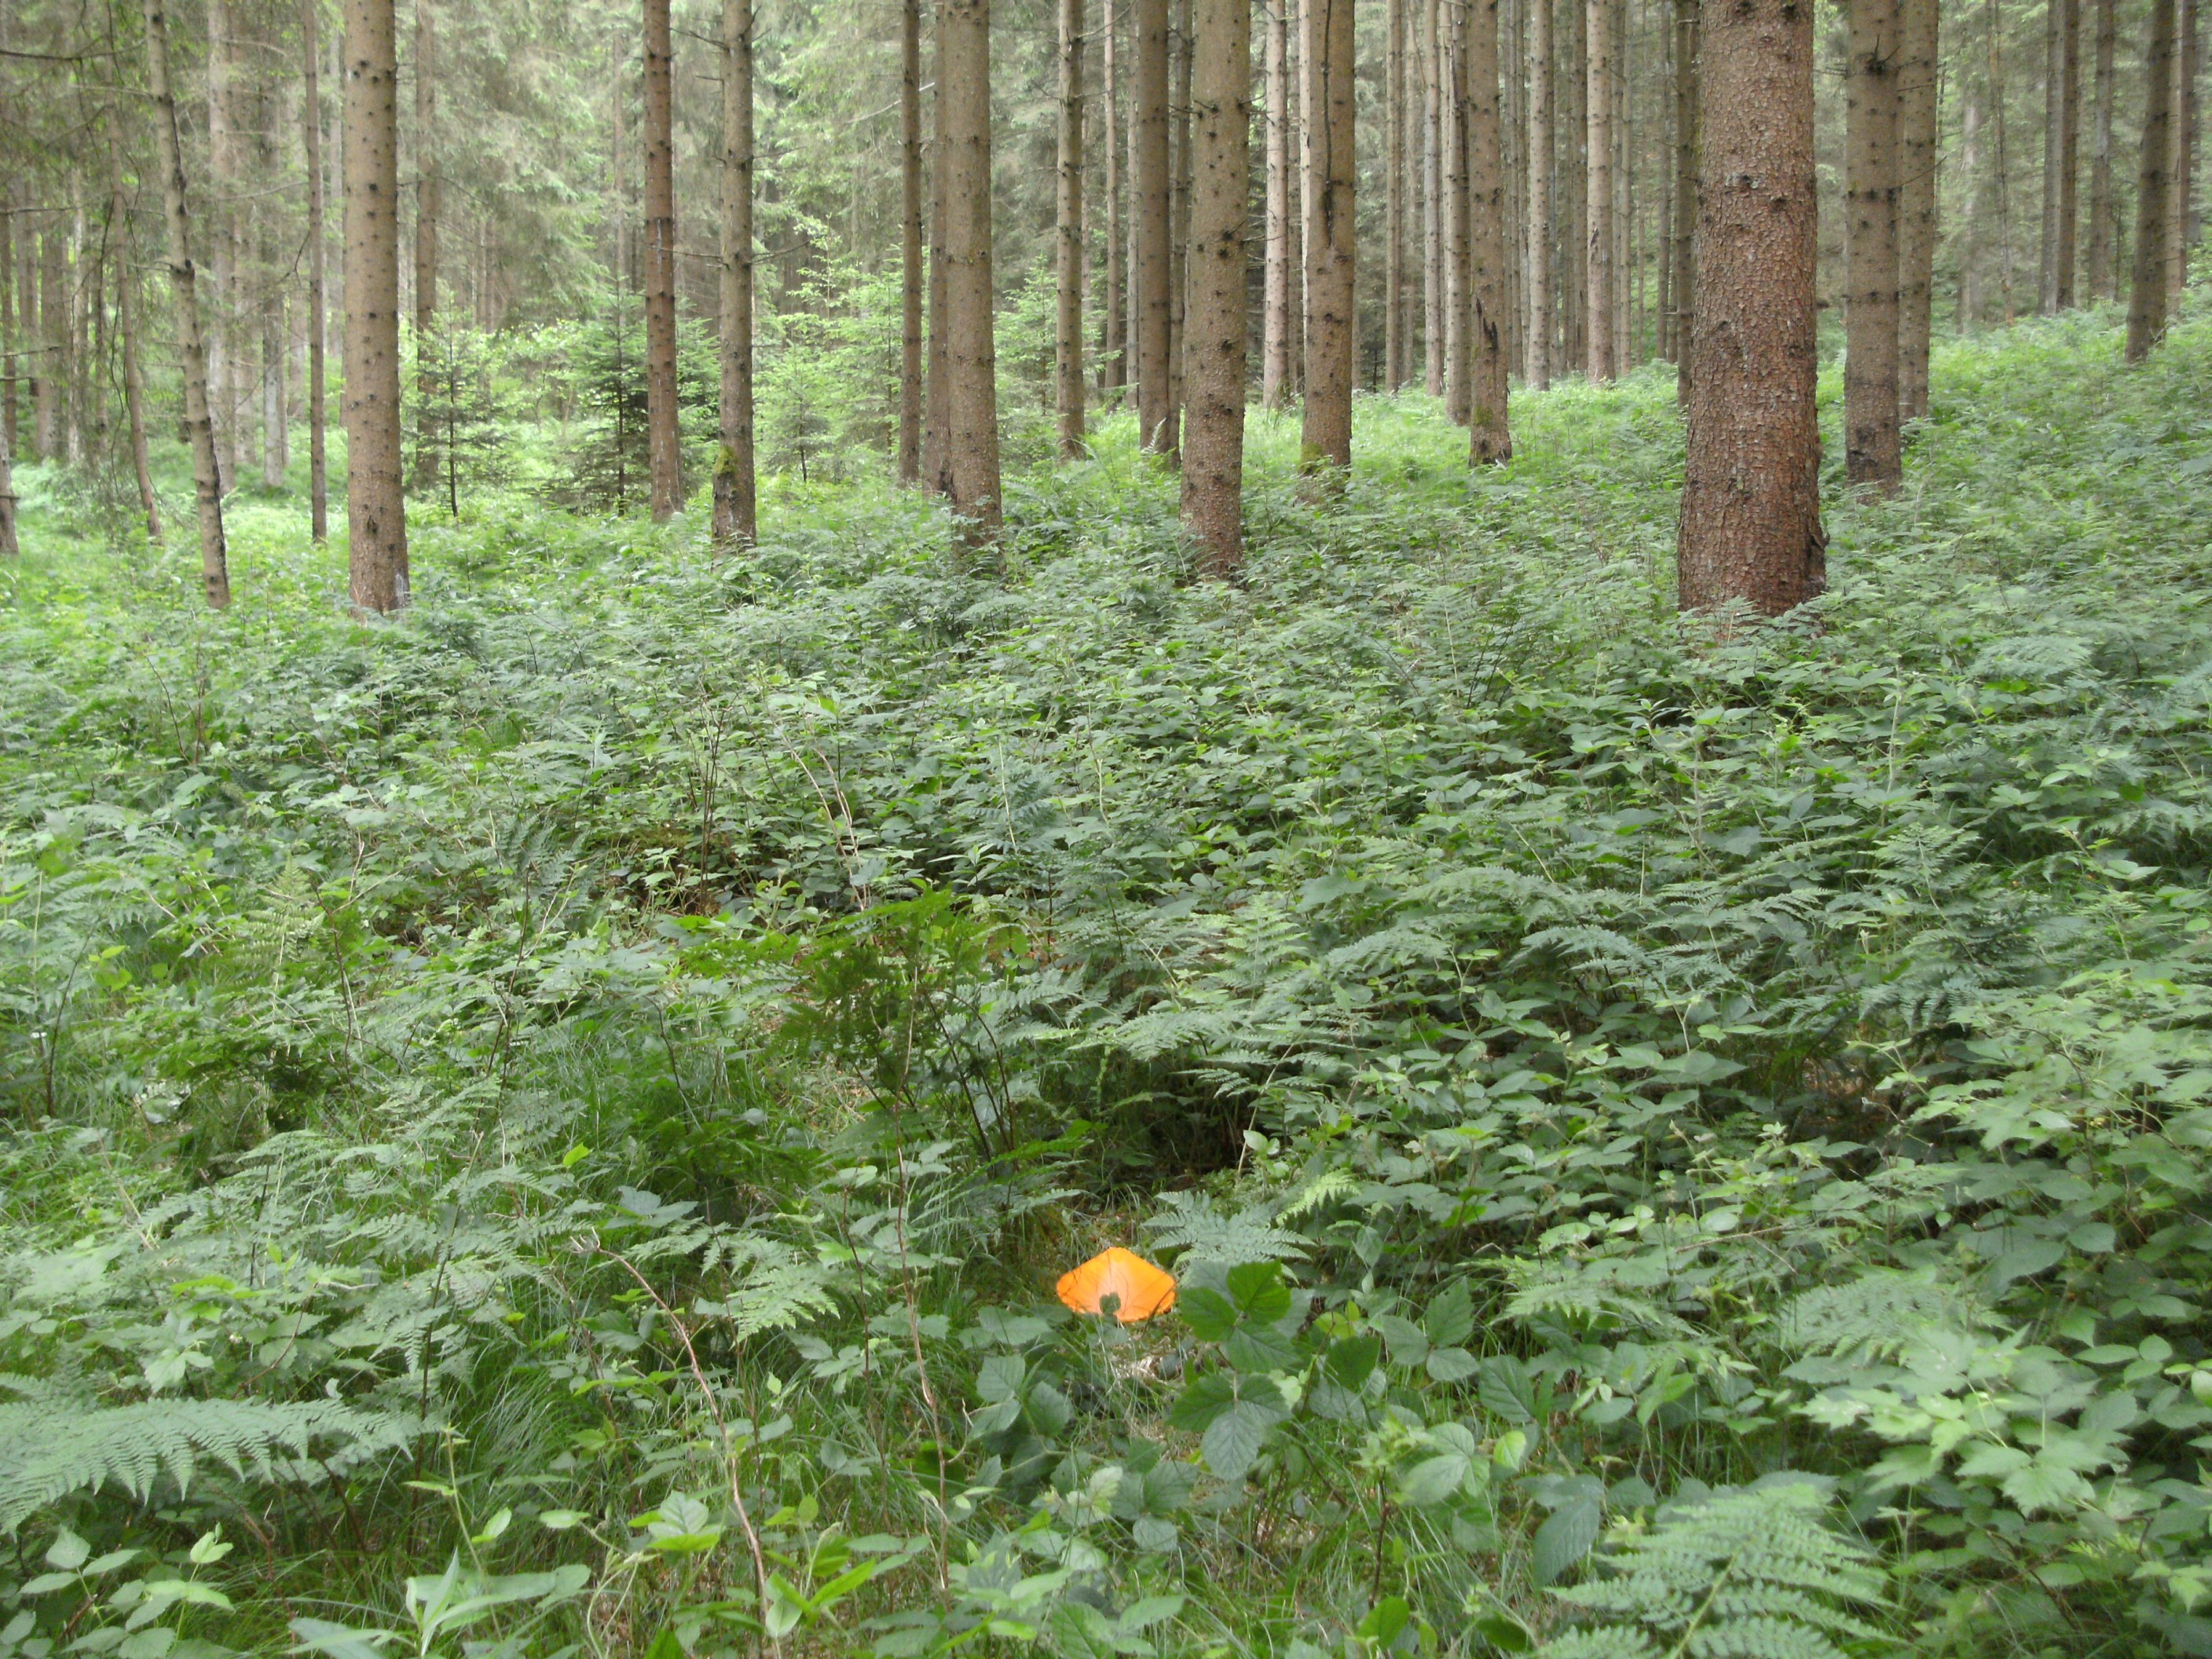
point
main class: Woodland
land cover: Spruce dominated coniferous woodland
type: hemiboreal forest and nemoral coniferous forest and mixed broadleaved-coniferous forest
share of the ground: 50 - 75 %
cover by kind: coniferous forest trees 75 %, shrubs 10 %, herbaceous plants 10 %, broadleaved forest trees 5 %
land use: Forestry
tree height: > 5 m
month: June
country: AT
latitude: 48.5066
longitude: 14.1285
